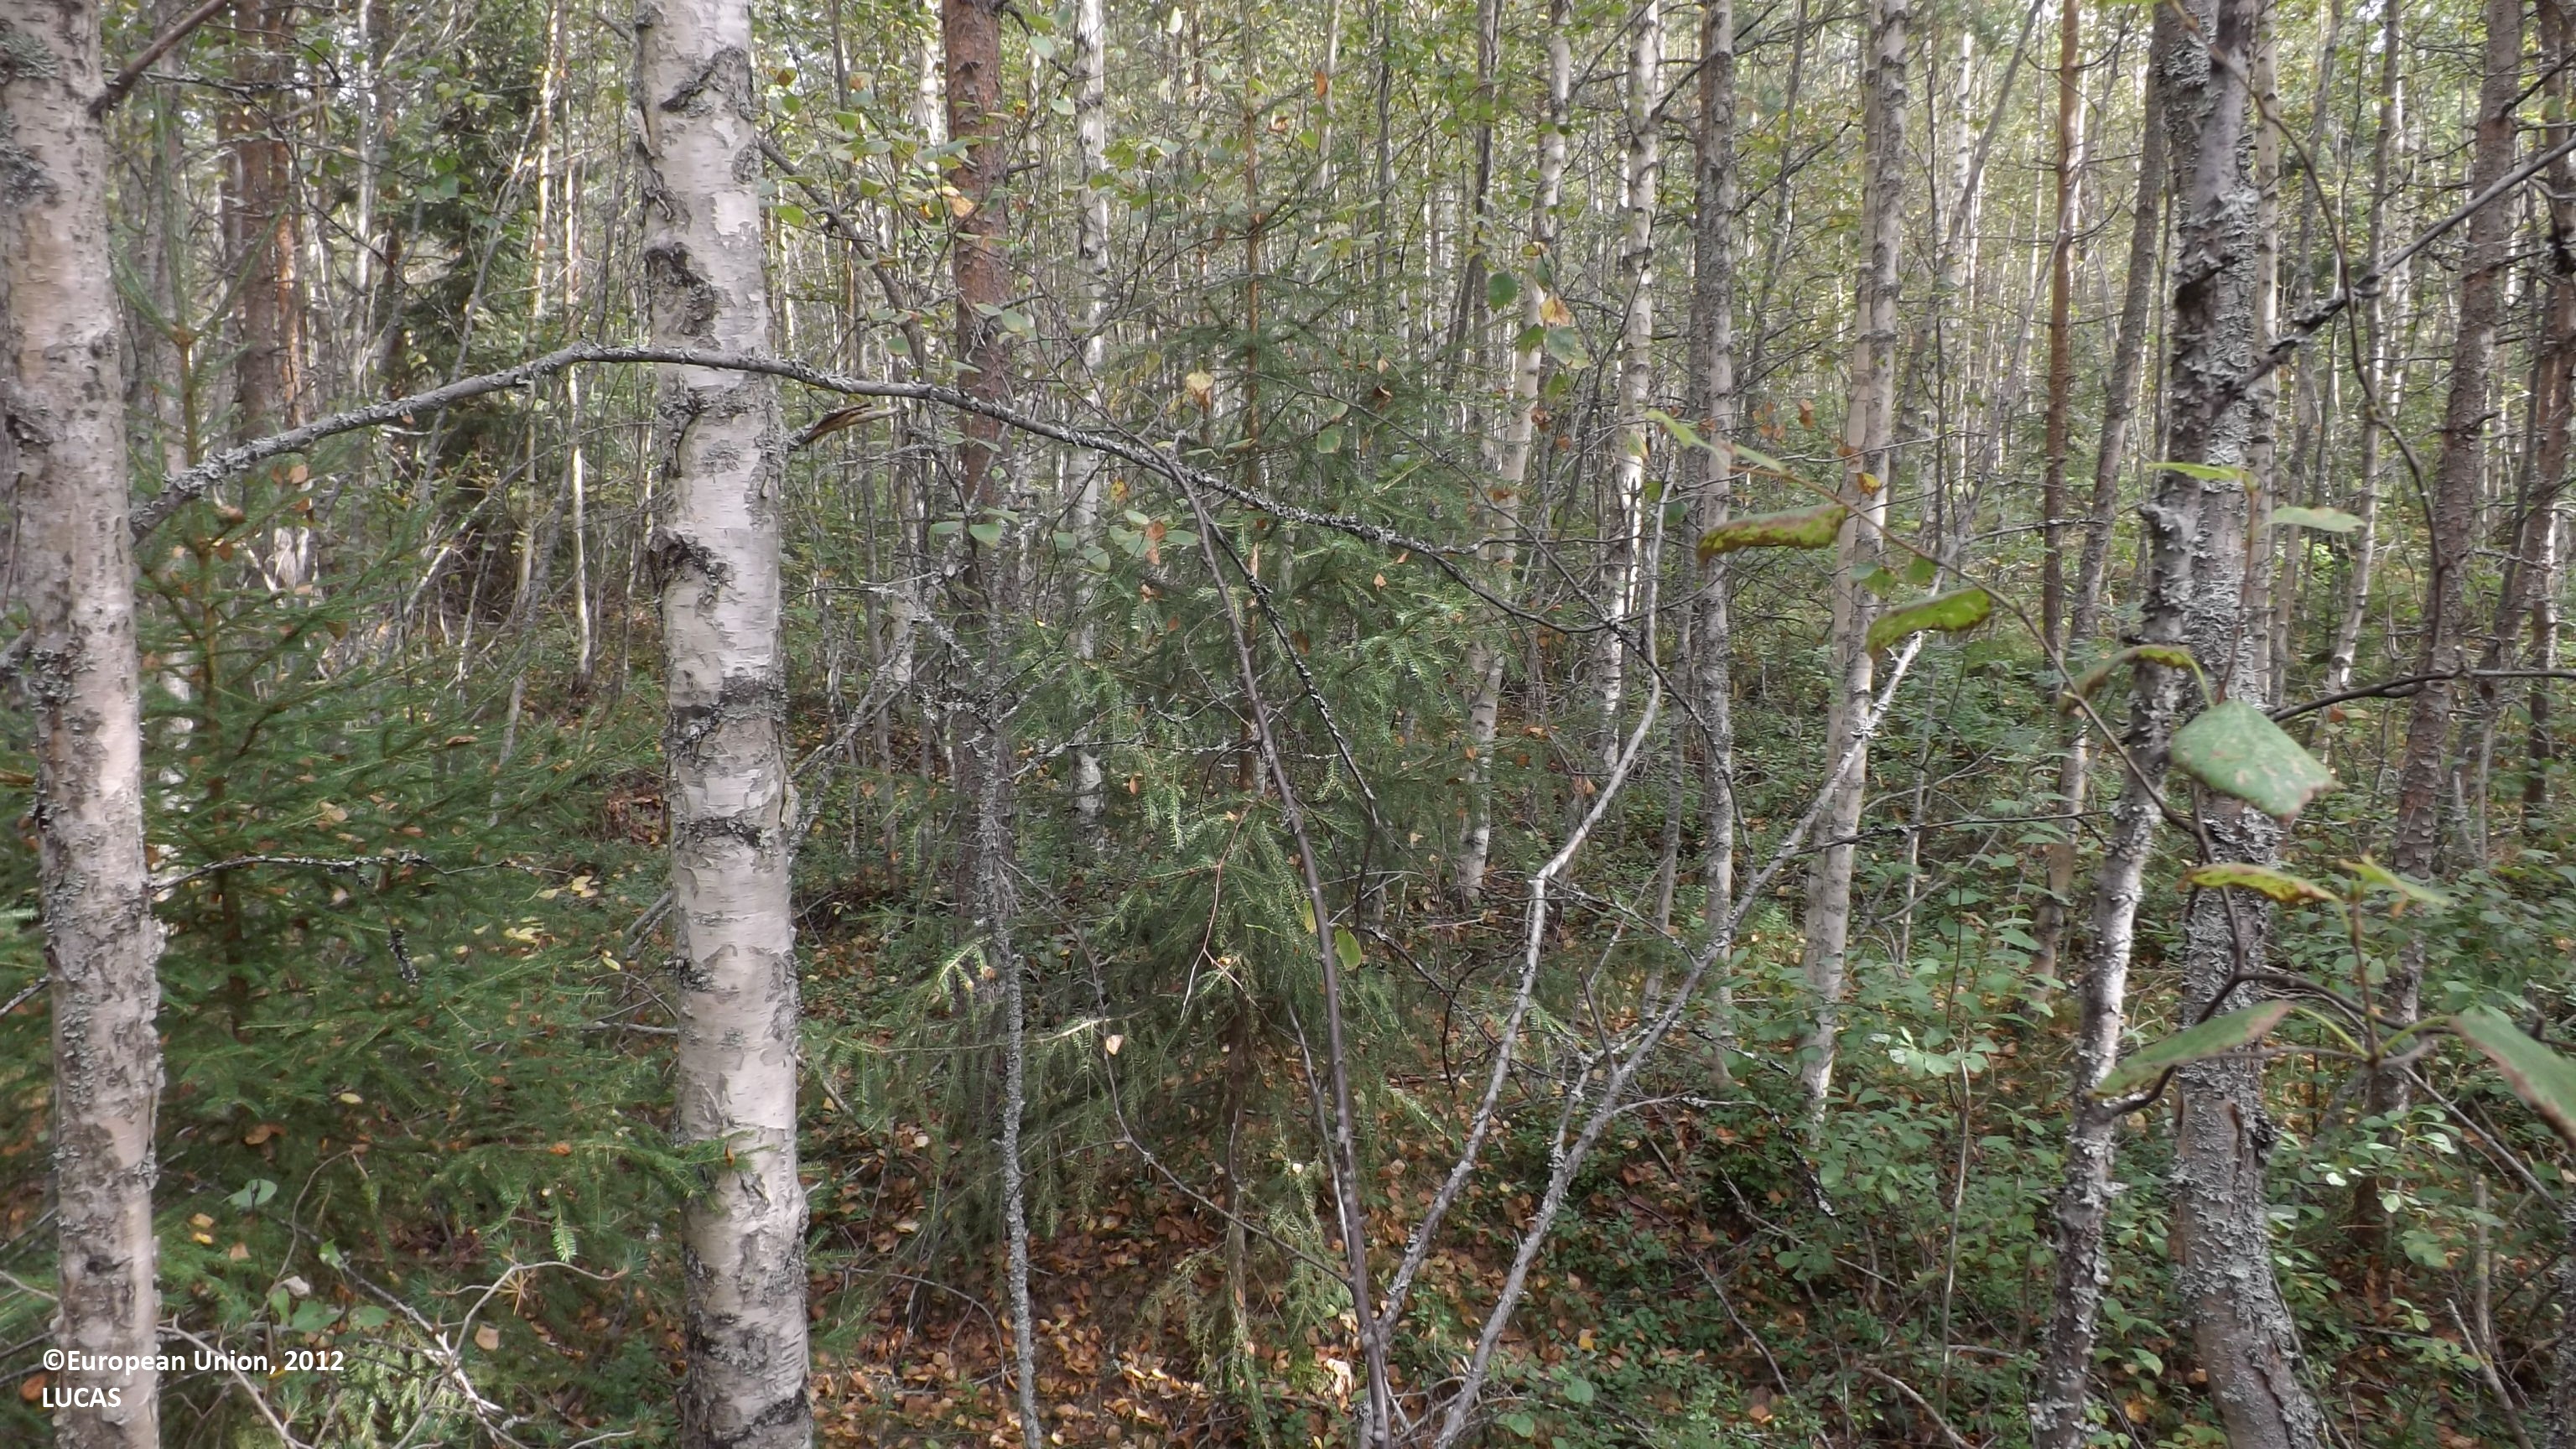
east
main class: Woodland
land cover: Other mixed woodland
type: boreal forest
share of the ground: > 75 %
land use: Forestry
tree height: > 5 m
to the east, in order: Other mixed woodland; Broadleaved woodland; Ditches and canals; Broadleaved woodland; Ditches and canals; Other mixed woodland; Pine dominated mixed woodland; Other mixed woodland; Spruce dominated mixed woodland; Ditches and canals; Broadleaved woodland; Ditches and canals; Other mixed woodland; Pine dominated mixed woodland
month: August
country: FI
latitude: 63.9179
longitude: 24.0313
